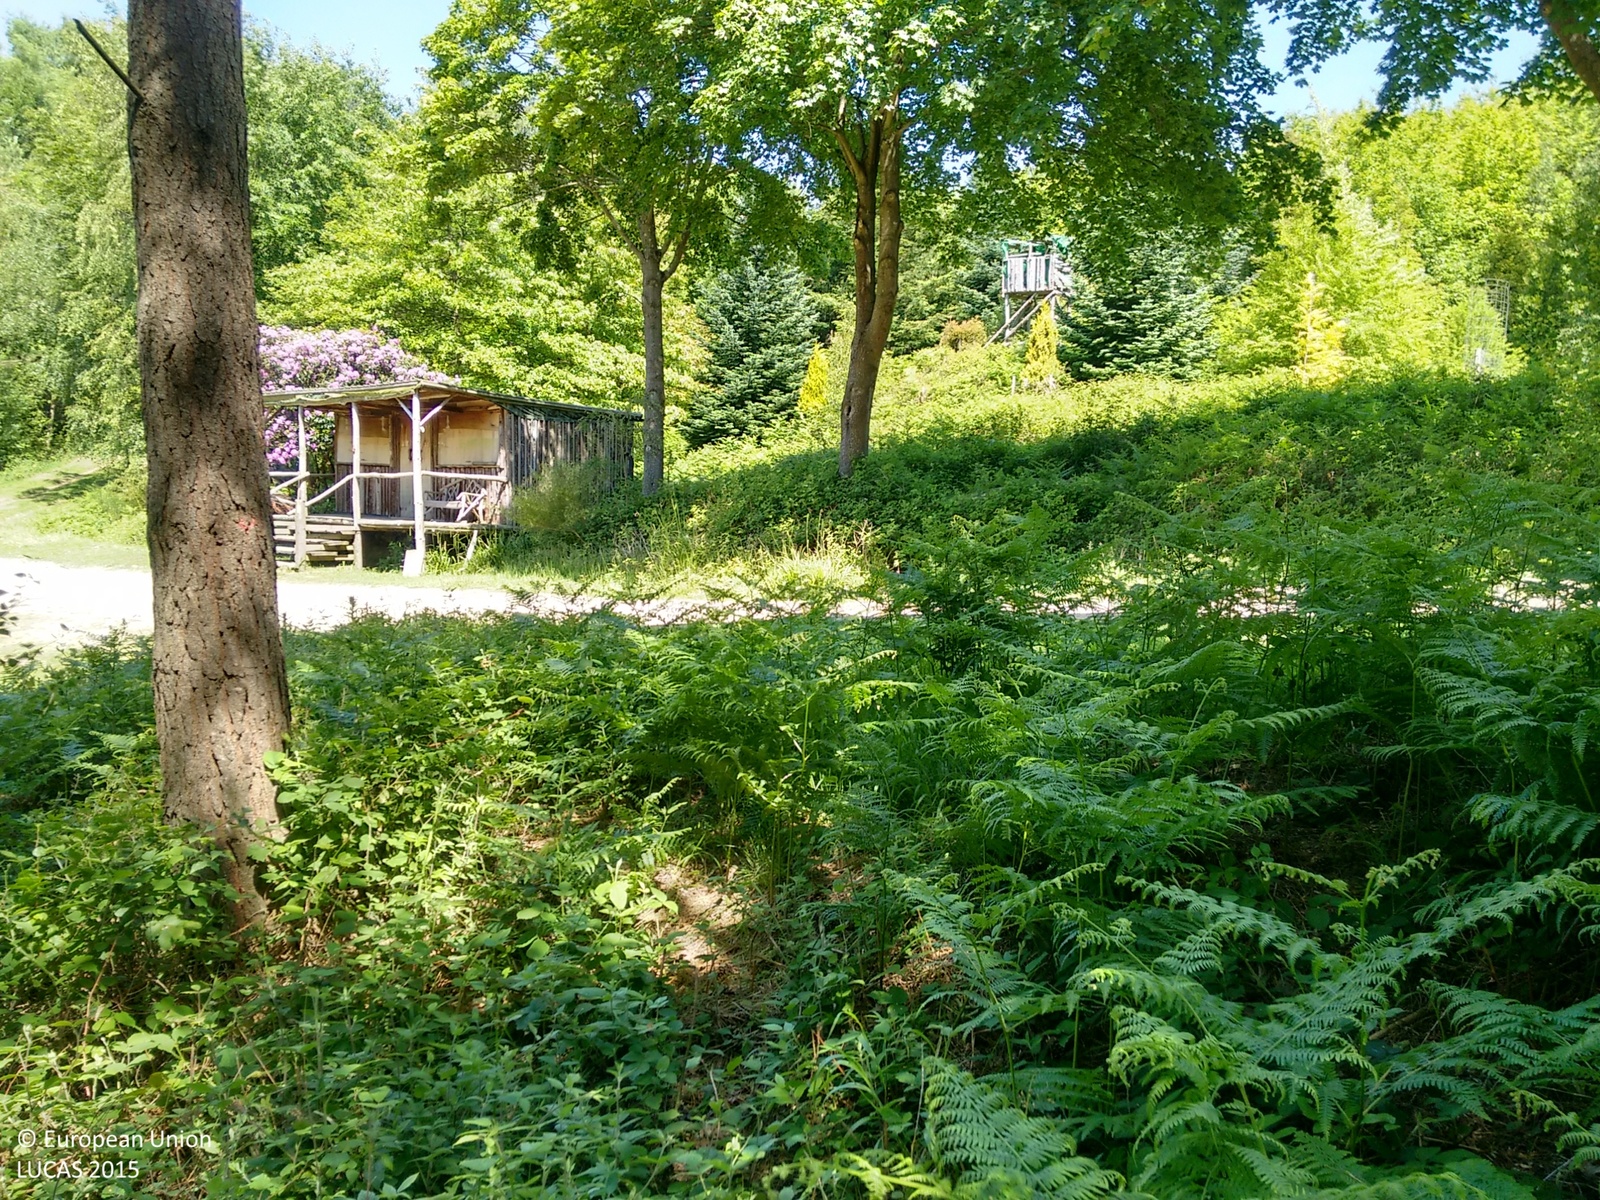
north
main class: Woodland
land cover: Pine dominated coniferous woodland
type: exotic forest
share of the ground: > 75 %
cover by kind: coniferous forest trees 85 %, shrubs 10 %, herbaceous plants 5 %
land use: Forestry
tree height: > 5 m
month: June
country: GB
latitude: 50.9771
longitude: 0.4433
